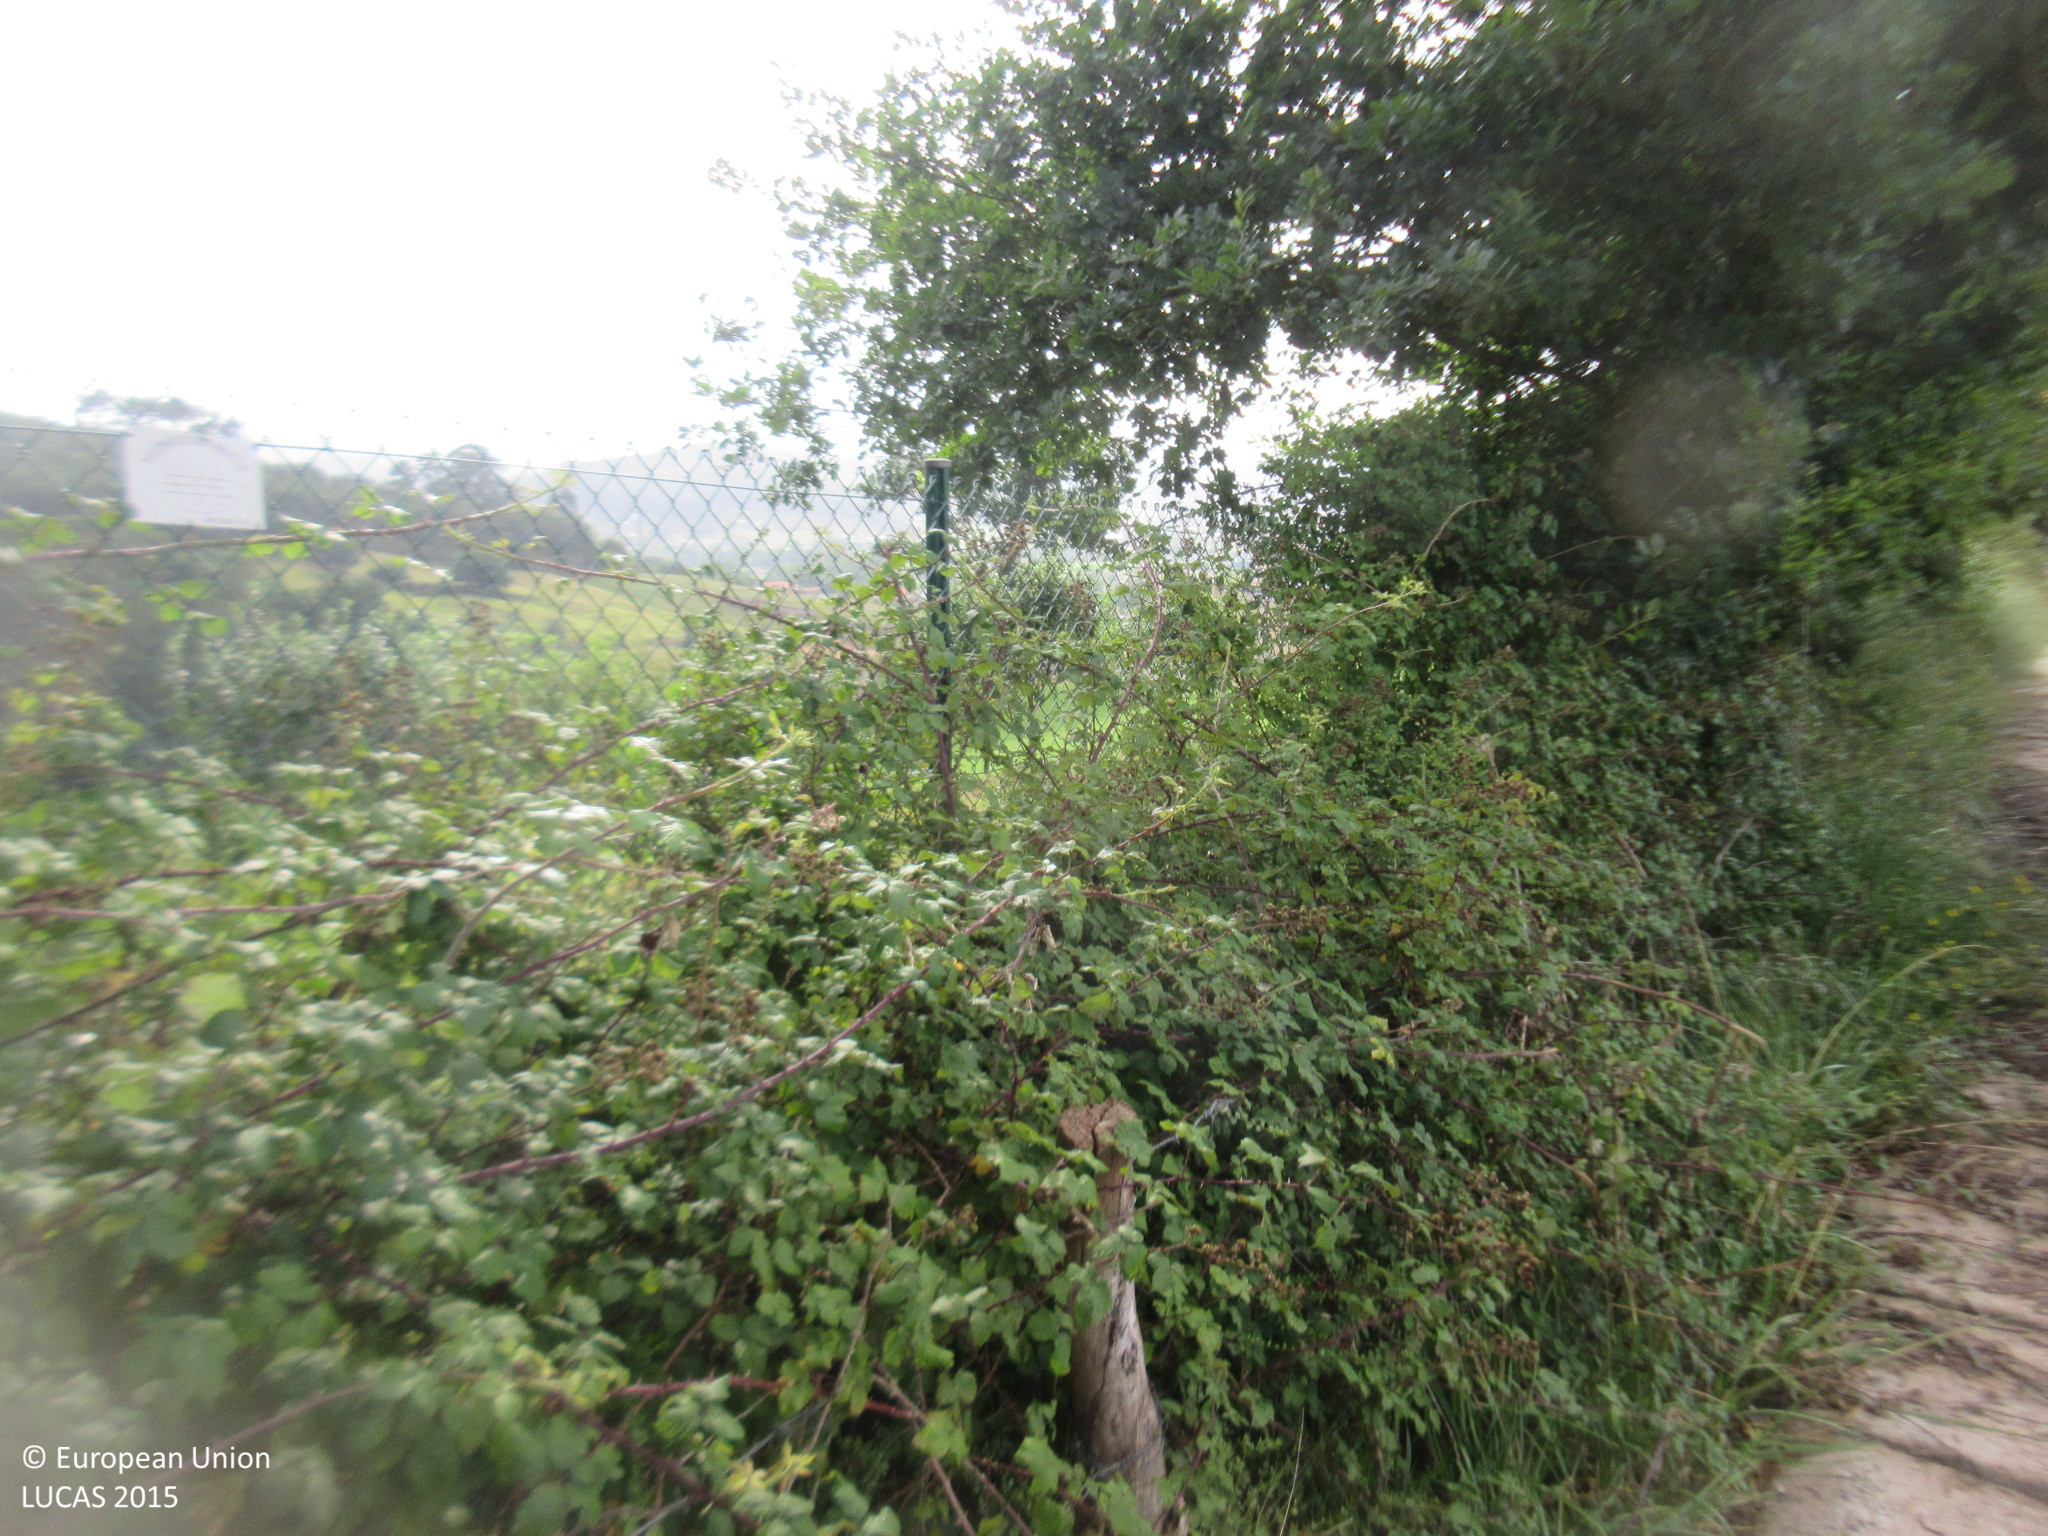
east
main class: Cropland
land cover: Apple fruit
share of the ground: 50 - 75 %
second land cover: Grassland without tree/shrub cover
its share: > 75 %
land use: Agriculture (excluding fallow land and kitchen gardens)
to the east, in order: Shruby margins; Apple fruit; Grassland without tree/shrub cover; Fences; Grassland without tree/shrub cover; Other bare soil; Electric lines; Other bare soil; Grassland without tree/shrub cover
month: July
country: ES
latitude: 43.3619
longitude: -3.9823
